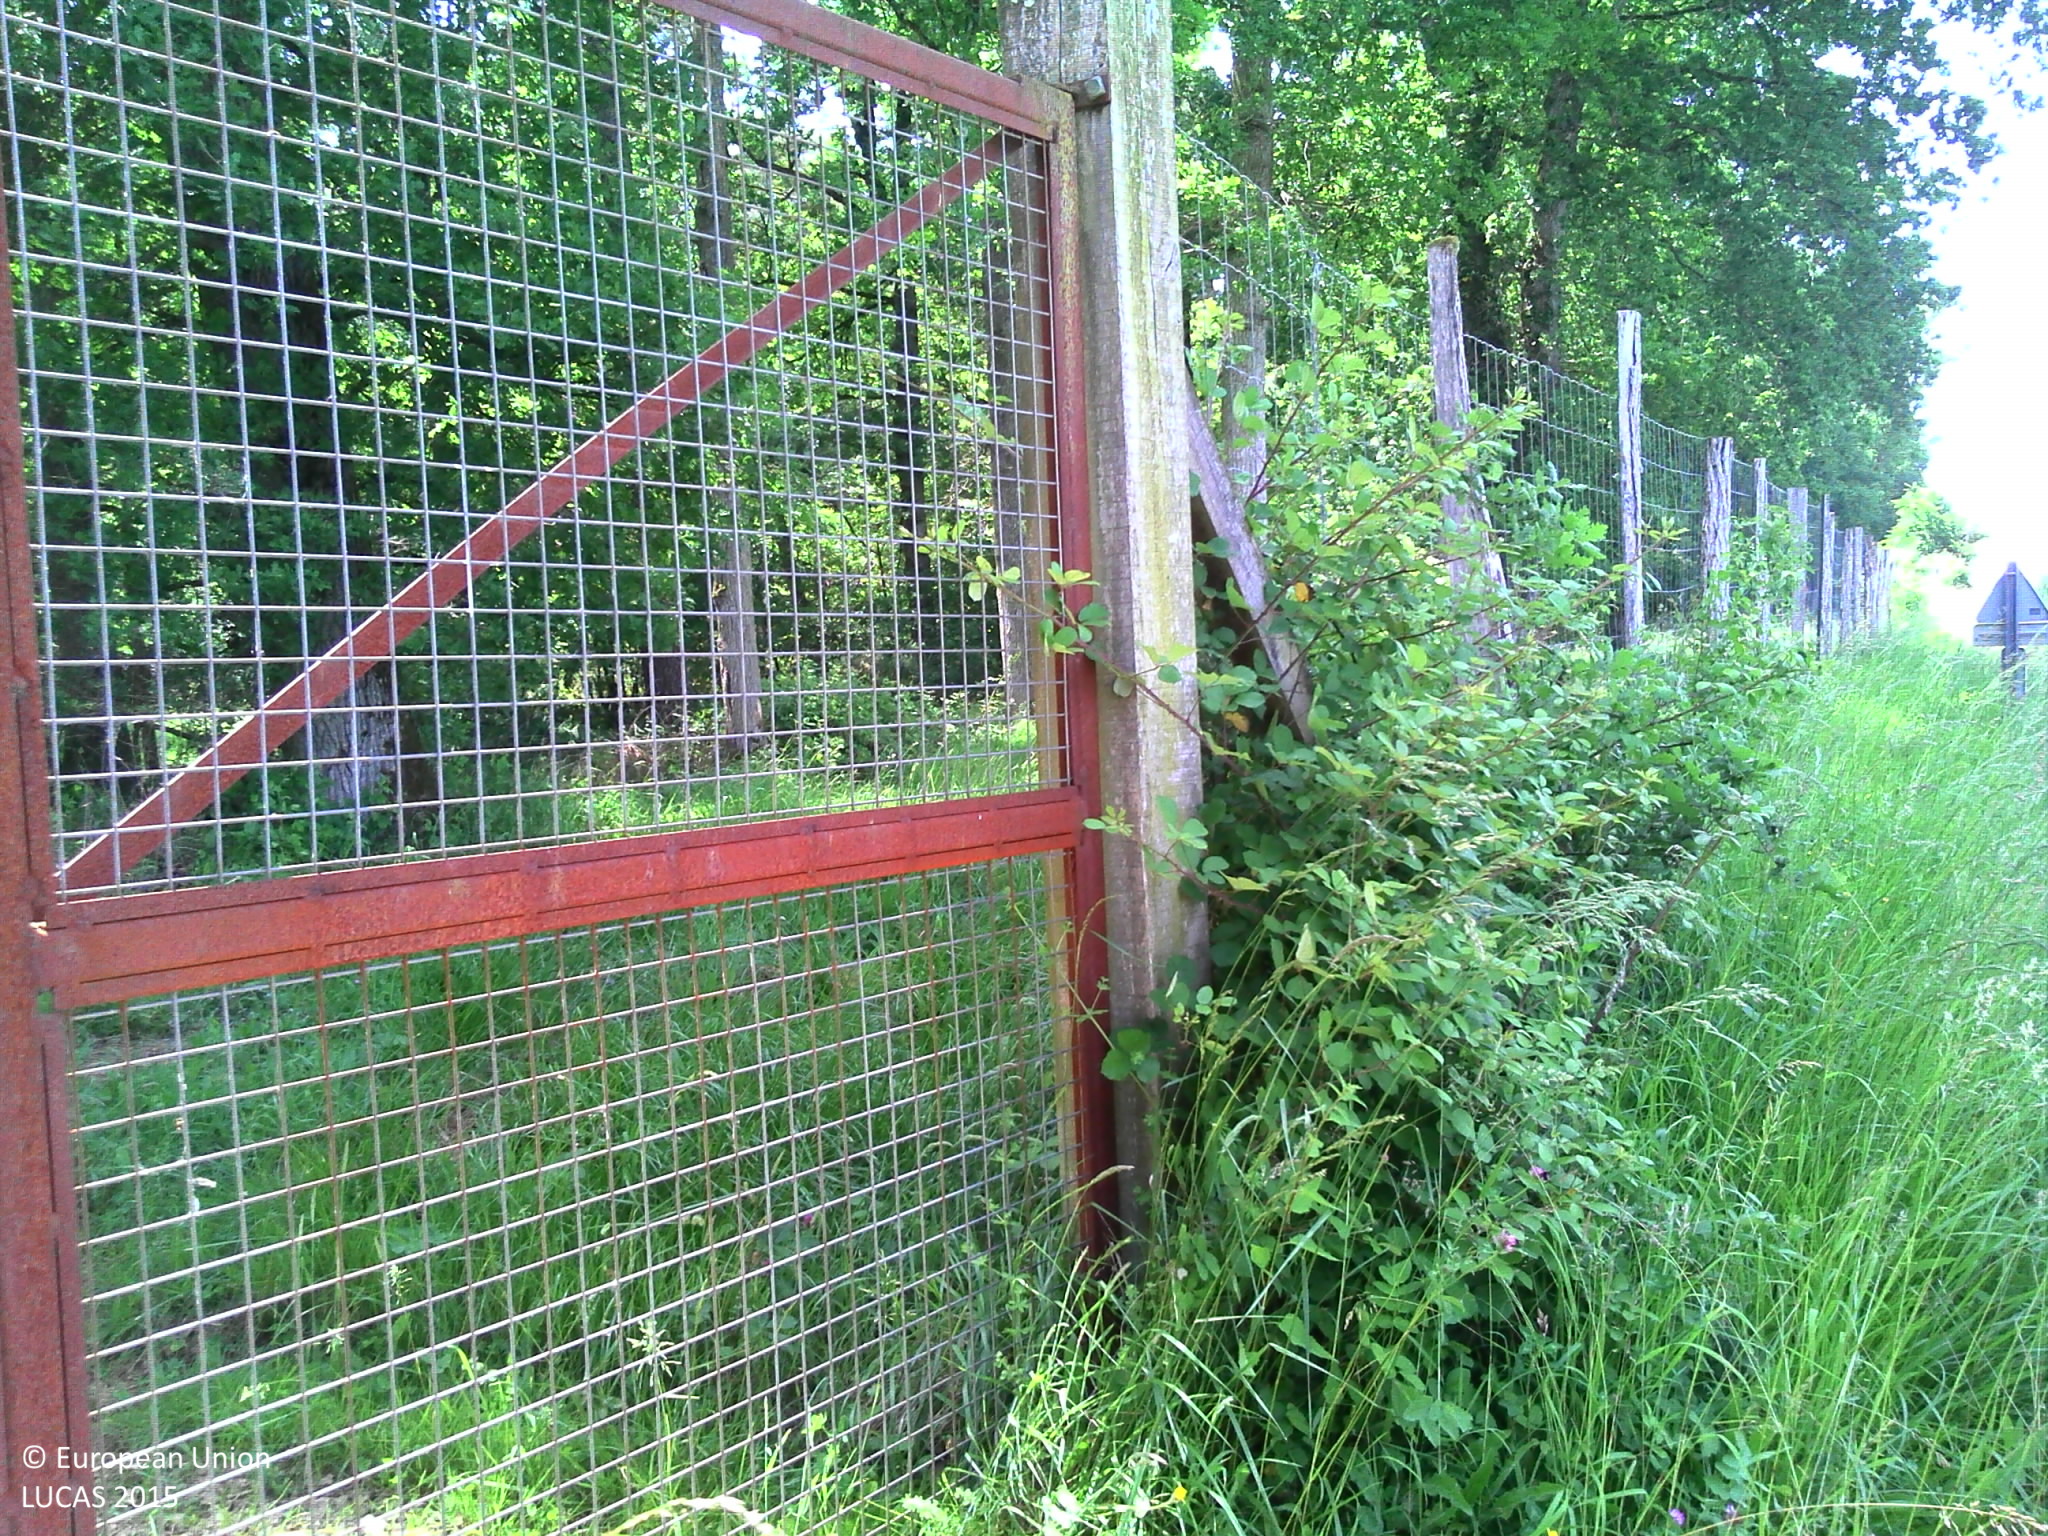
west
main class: Woodland
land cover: Broadleaved woodland
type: mesophytic deciduous forest
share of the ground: > 75 %
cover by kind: broadleaved forest trees 85 %, shrubs 10 %, herbaceous plants 5 %
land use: Forestry
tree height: > 5 m
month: June
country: FR
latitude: 46.9997
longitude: 0.1271
